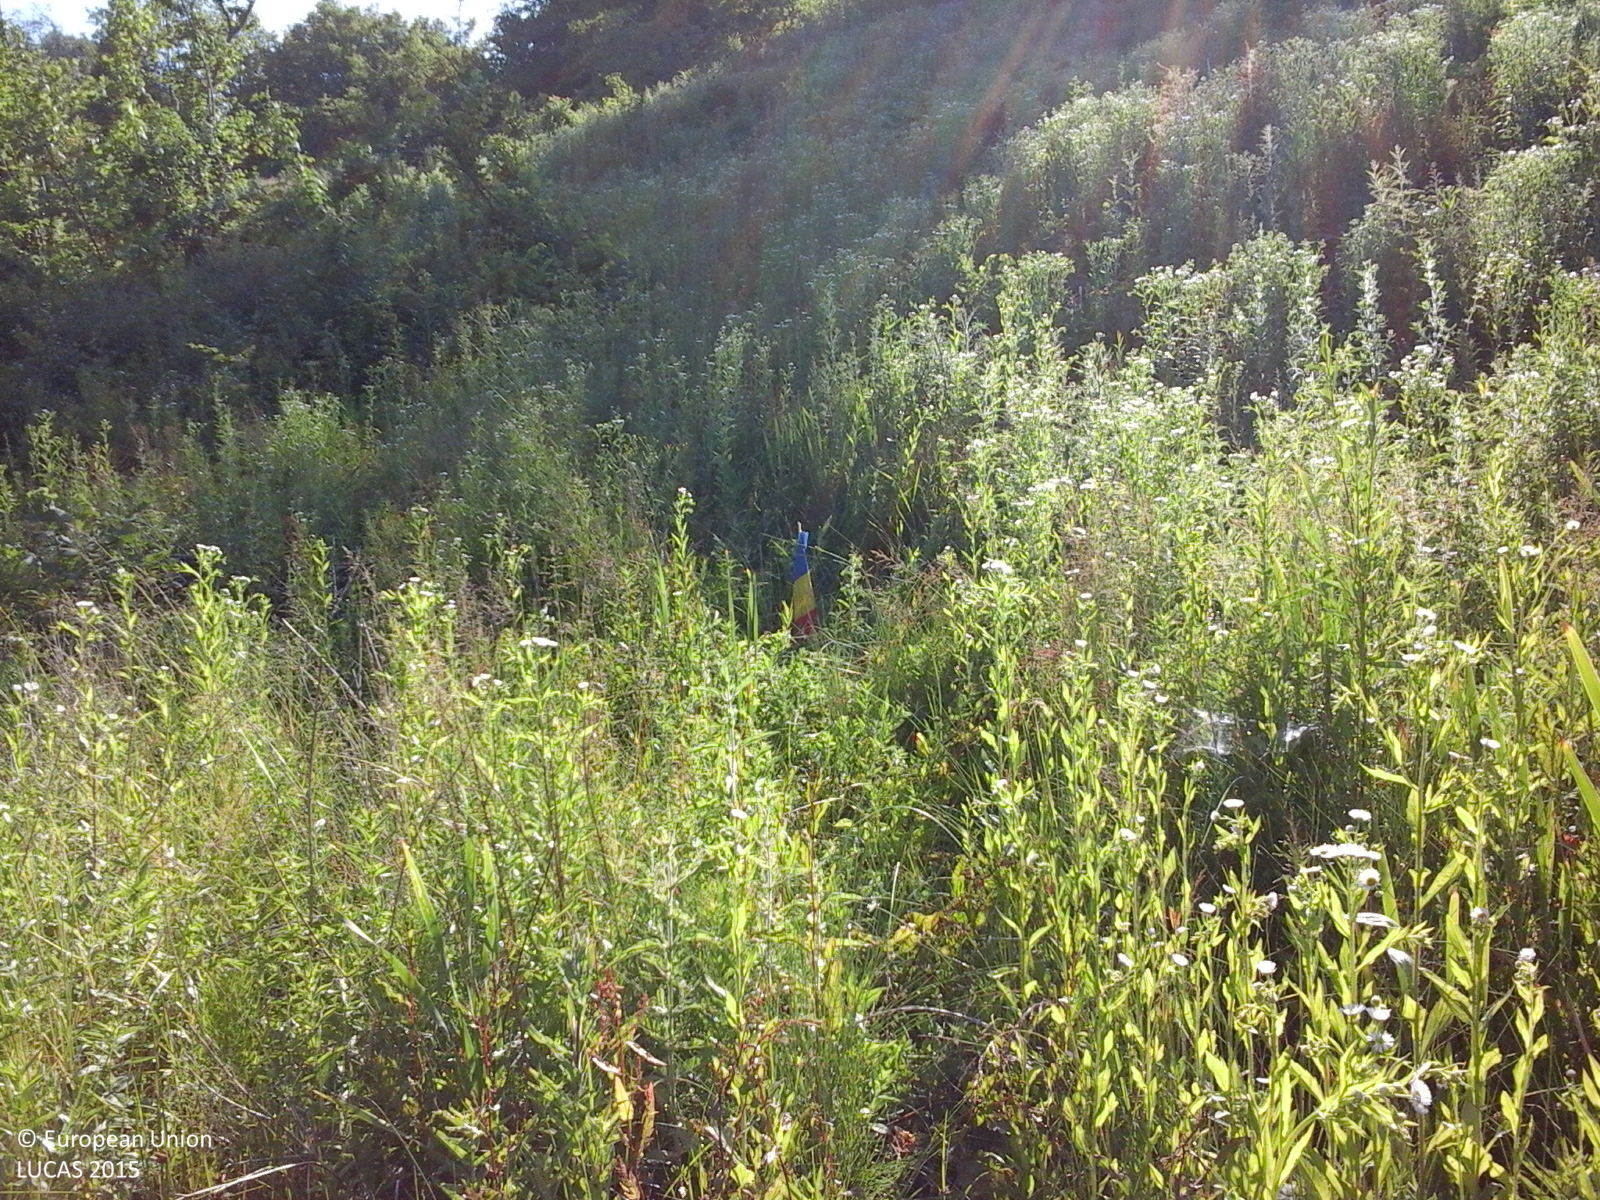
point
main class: Grassland
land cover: Spontaneously vegetated surfaces
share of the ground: > 75 %
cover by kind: herbaceous plants 100 %
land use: Forestry
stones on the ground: < 10 %
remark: Clear cut
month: June
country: RO
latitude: 45.1083
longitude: 25.8271
